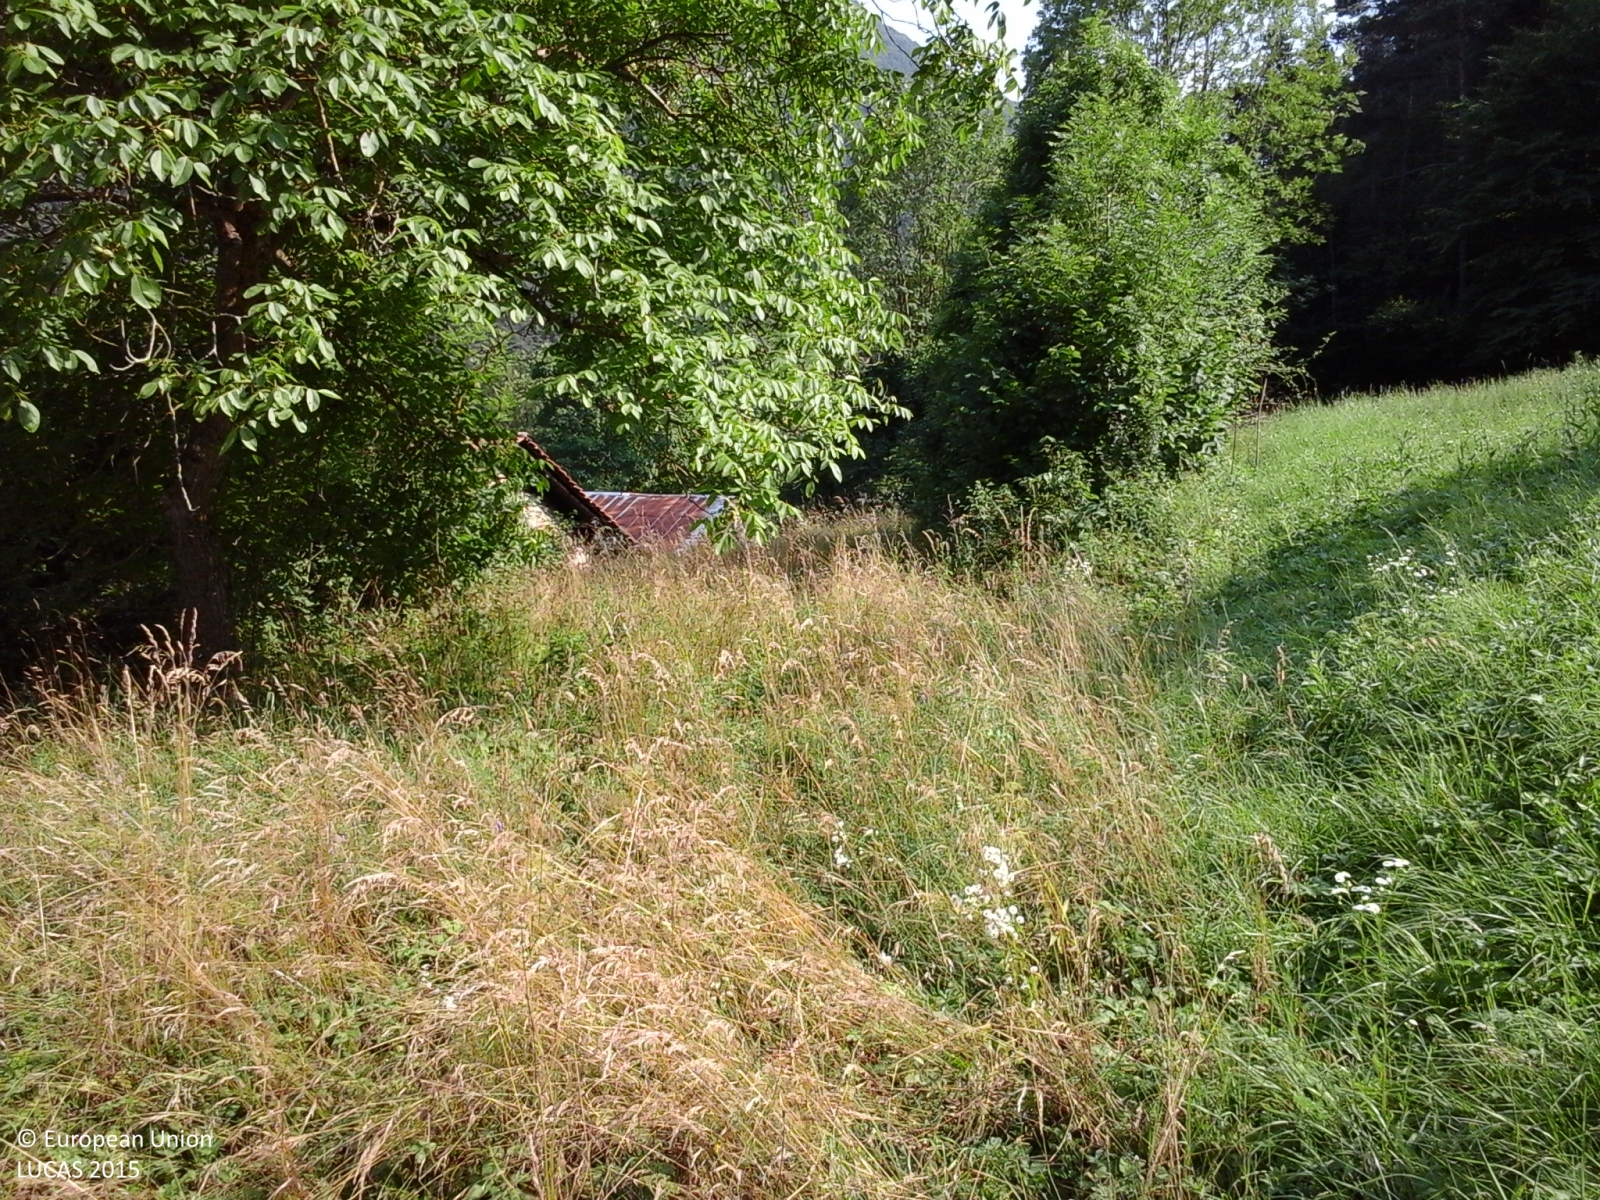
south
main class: Grassland
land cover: Grassland with sparse tree/shrub cover
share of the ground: > 75 %
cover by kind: herbaceous plants 95 %, broadleaved forest trees 5 %
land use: Agriculture (excluding fallow land and kitchen gardens)
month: July
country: IT
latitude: 44.4599
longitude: 7.3032
